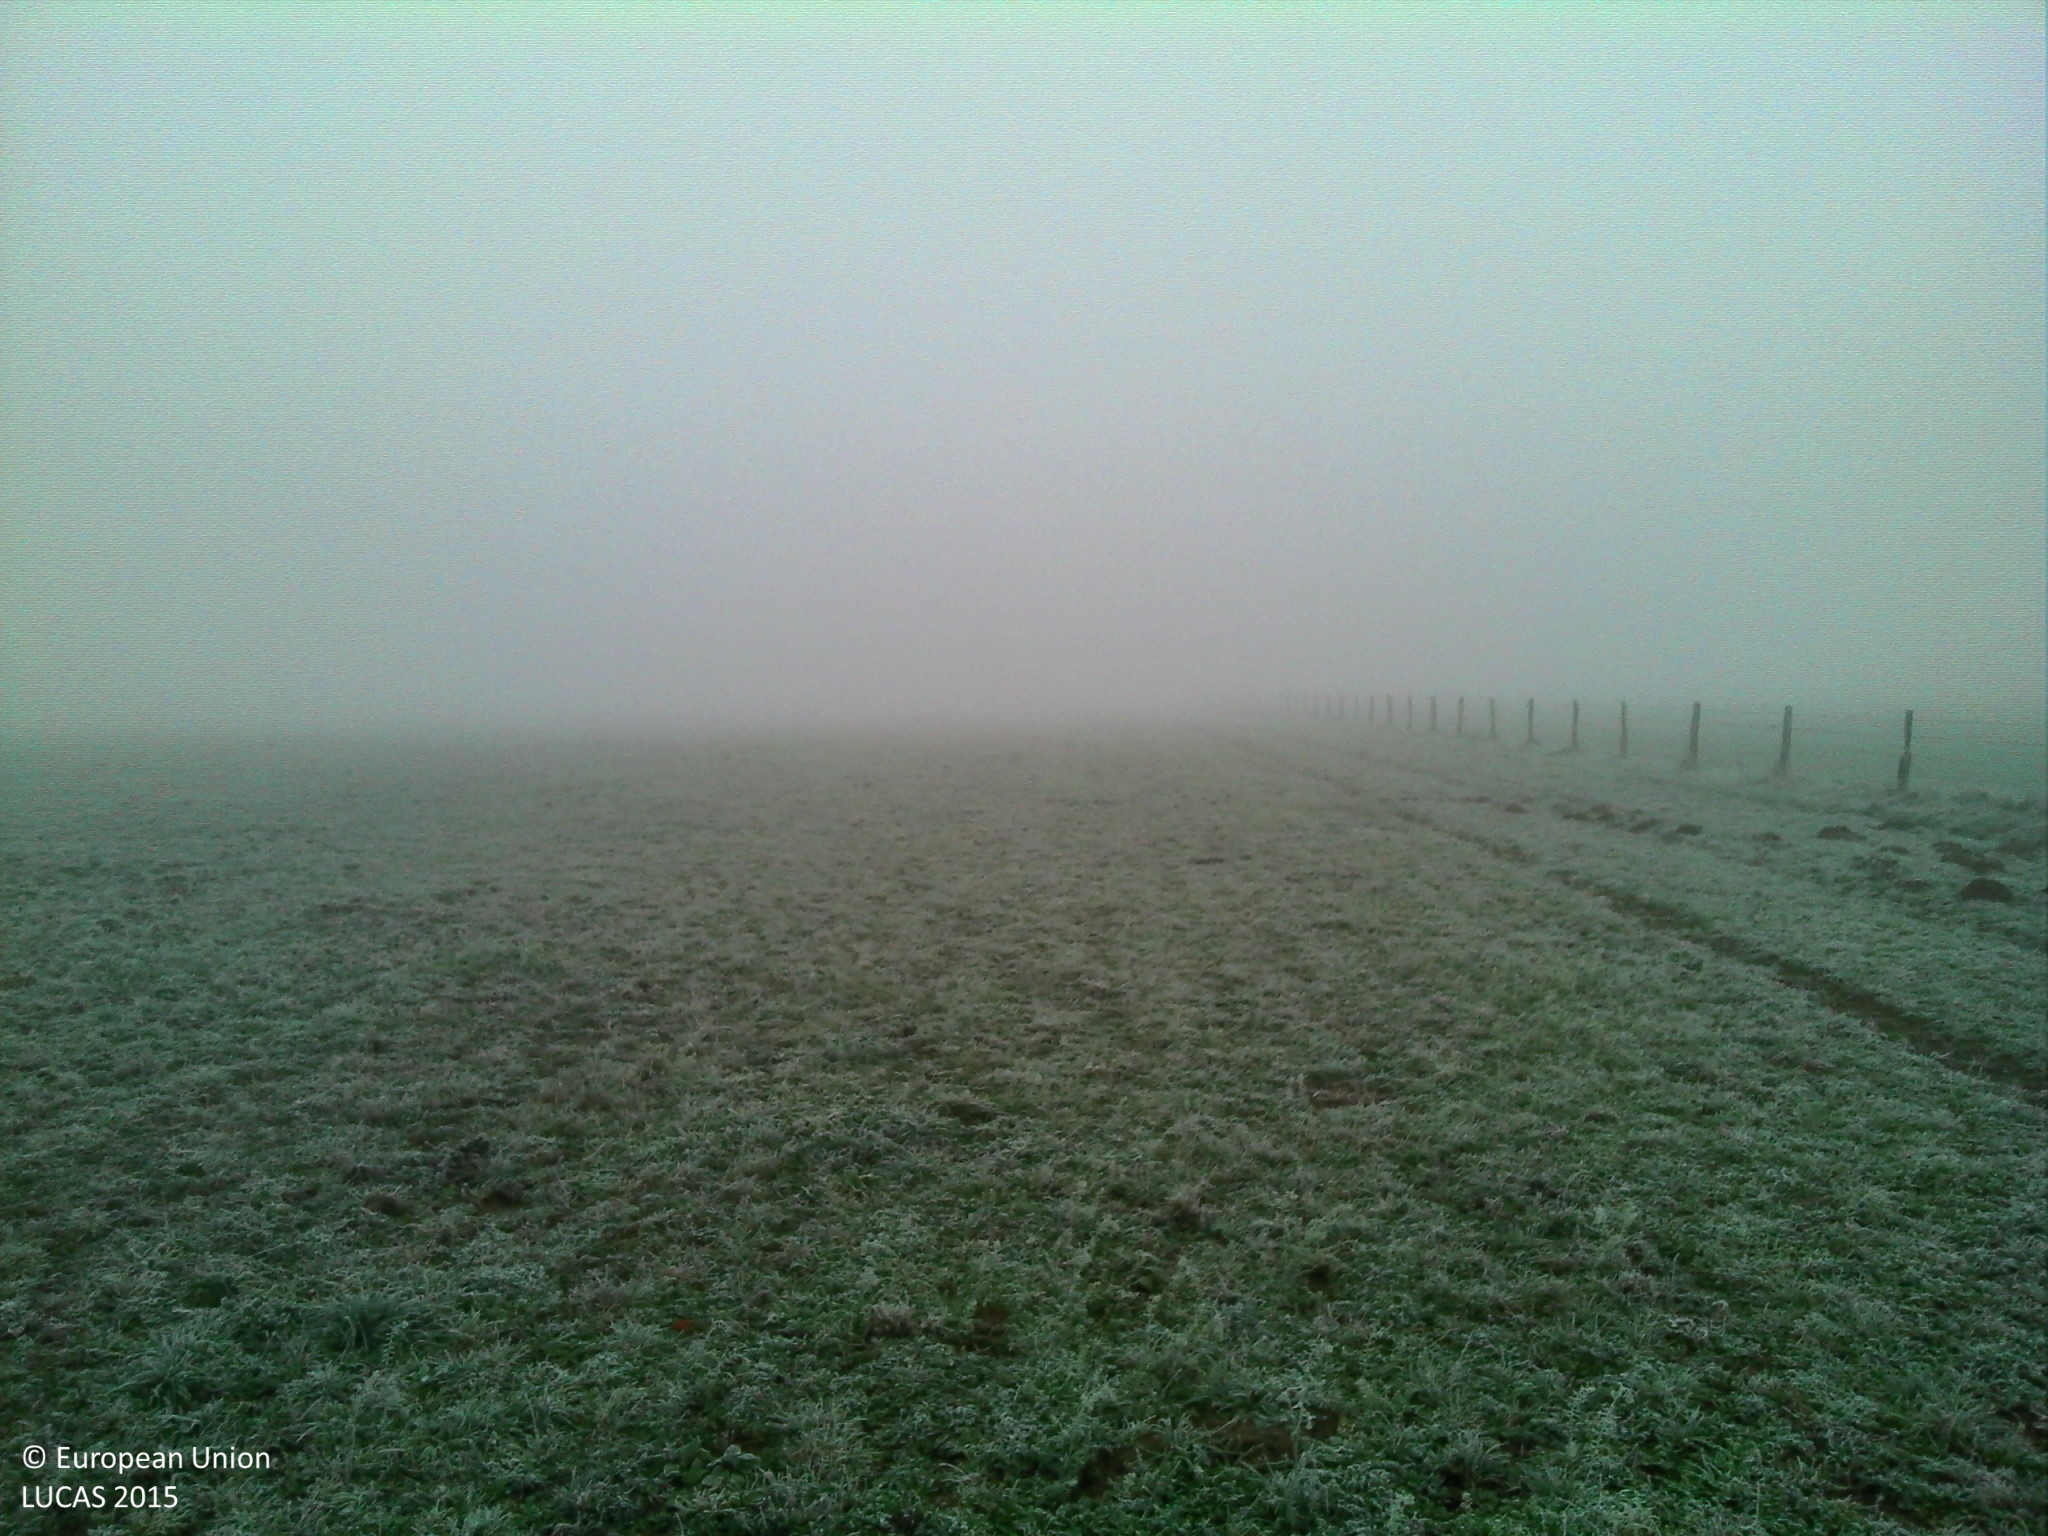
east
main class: Grassland
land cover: Grassland without tree/shrub cover
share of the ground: > 75 %
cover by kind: herbaceous plants 100 %
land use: Agriculture (excluding fallow land and kitchen gardens)
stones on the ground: < 10 %
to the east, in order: Grassland without tree/shrub cover; Fences; Grassland without tree/shrub cover
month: November
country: FR
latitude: 46.5566
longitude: 3.5945
